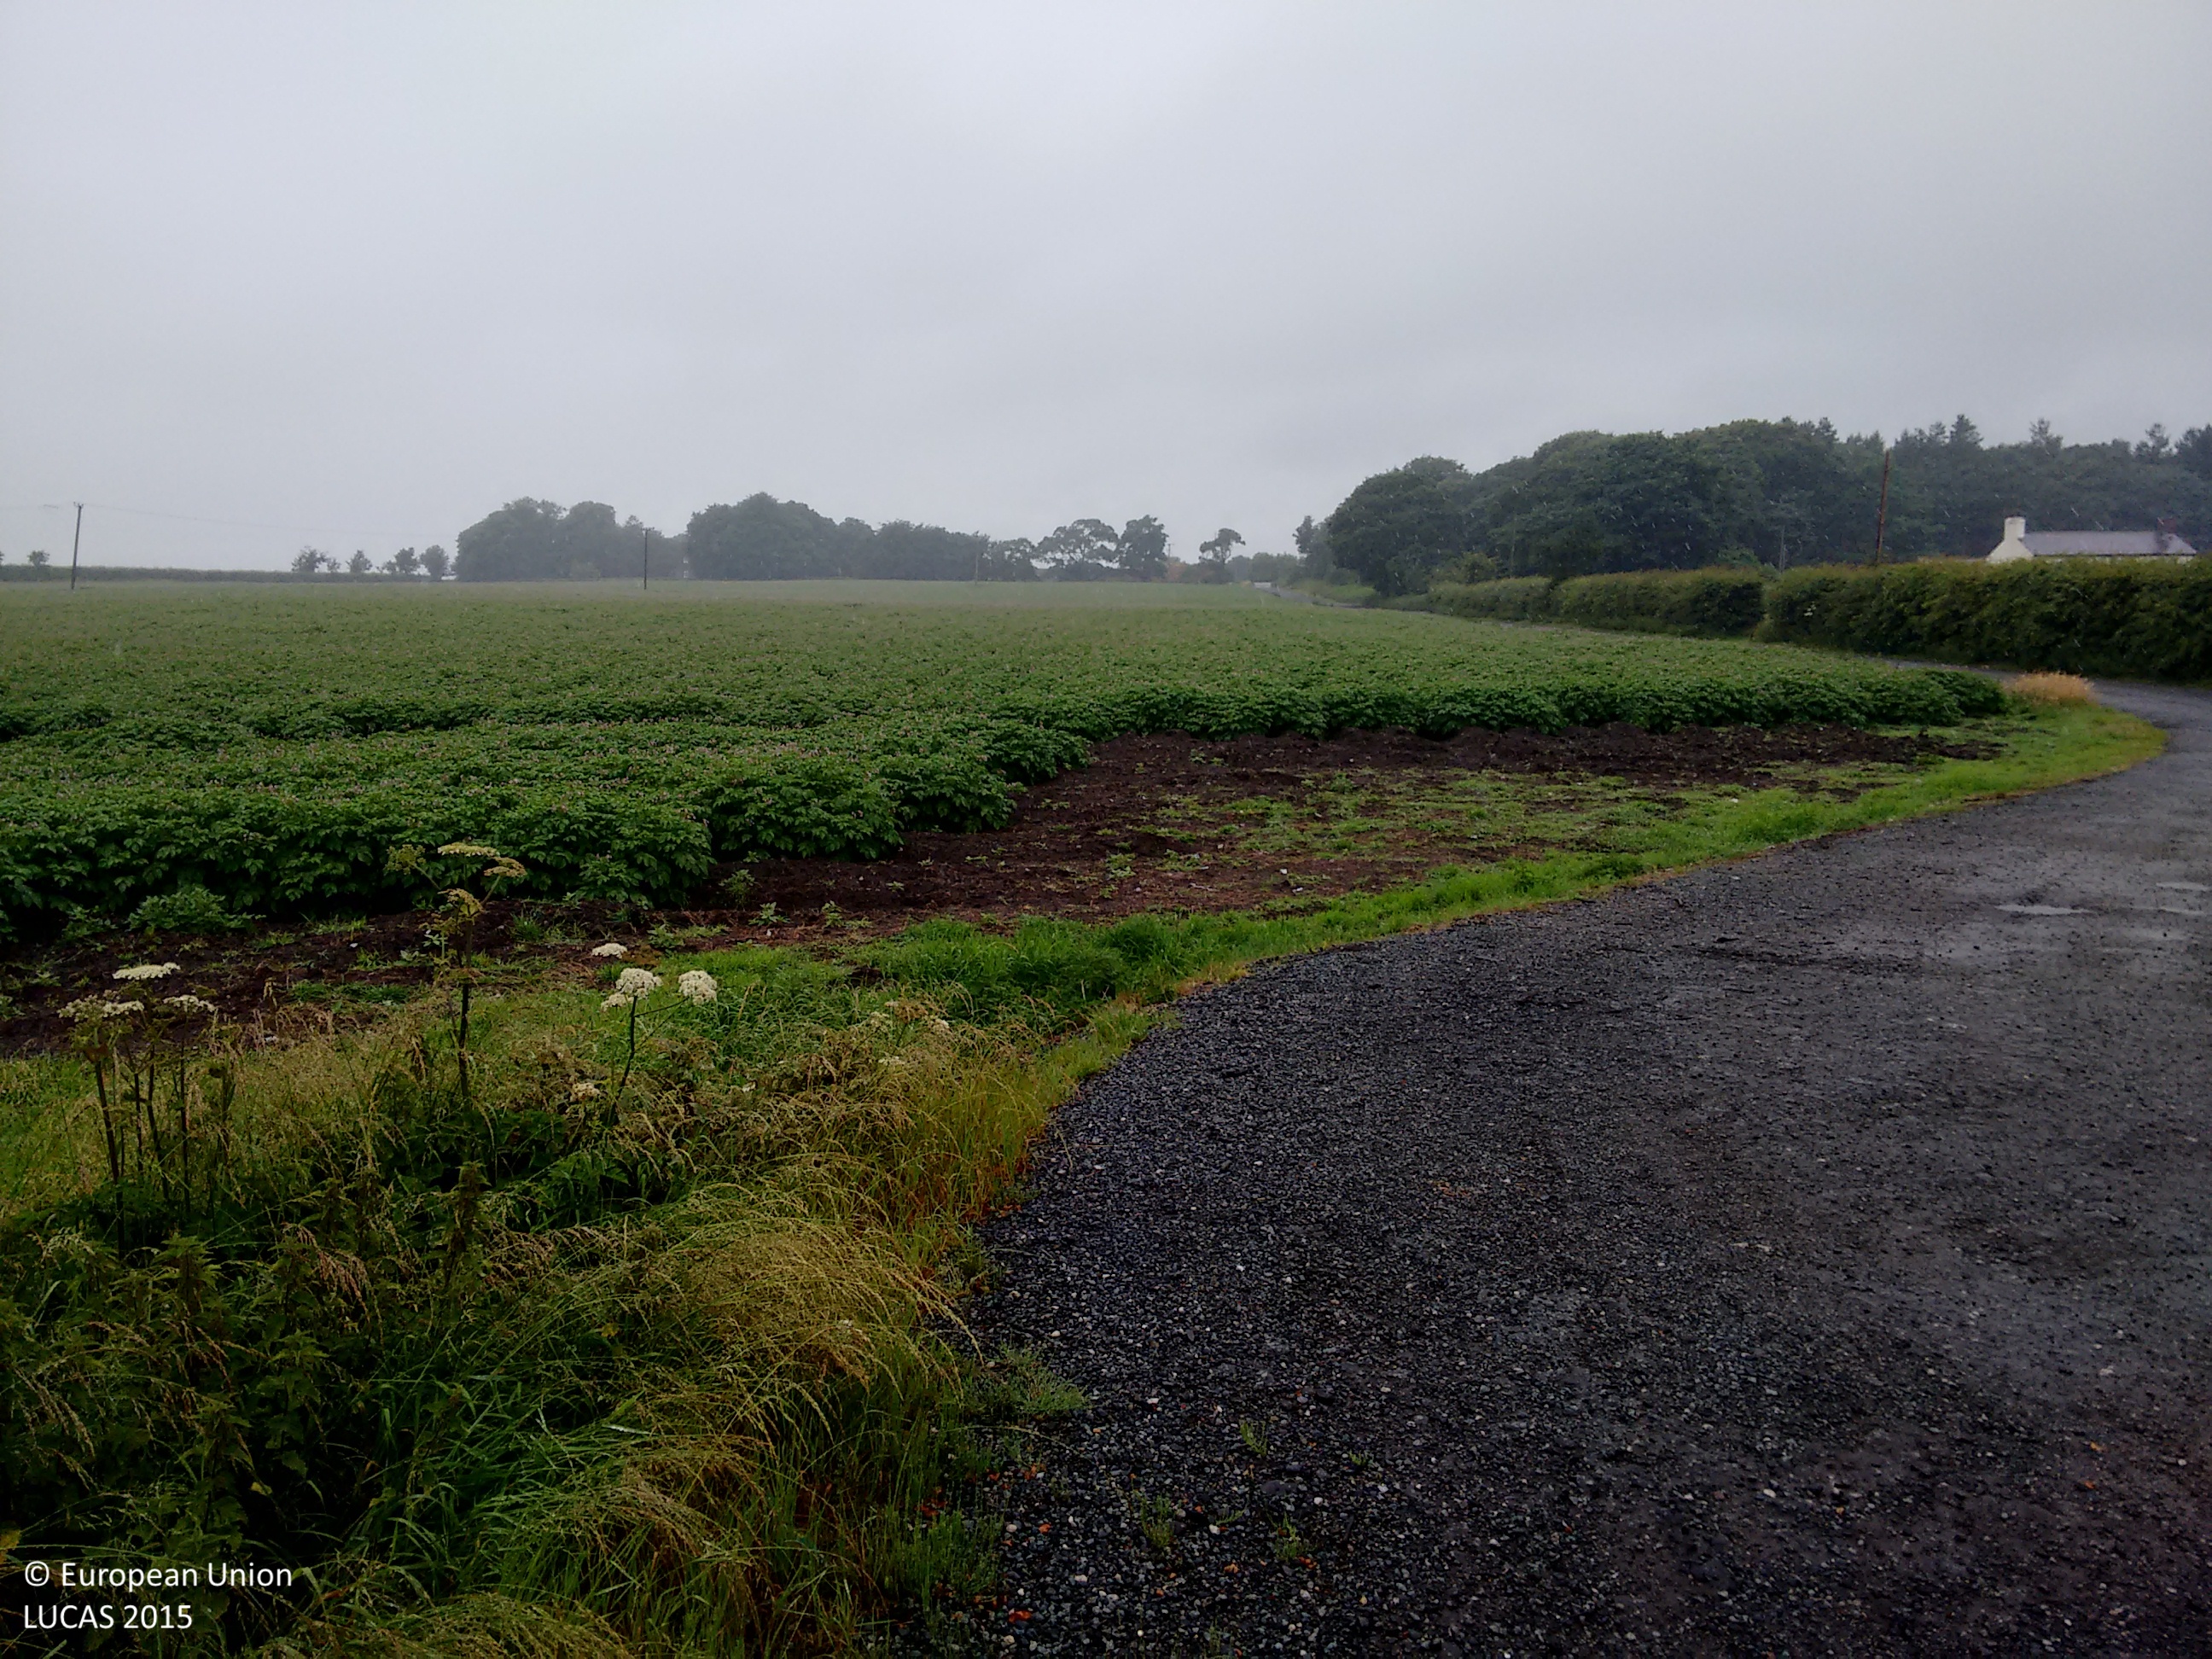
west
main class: Cropland
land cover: Potatoes
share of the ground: > 75 %
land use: Agriculture (excluding fallow land and kitchen gardens)
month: July
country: GB
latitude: 53.4836
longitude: -2.8046
